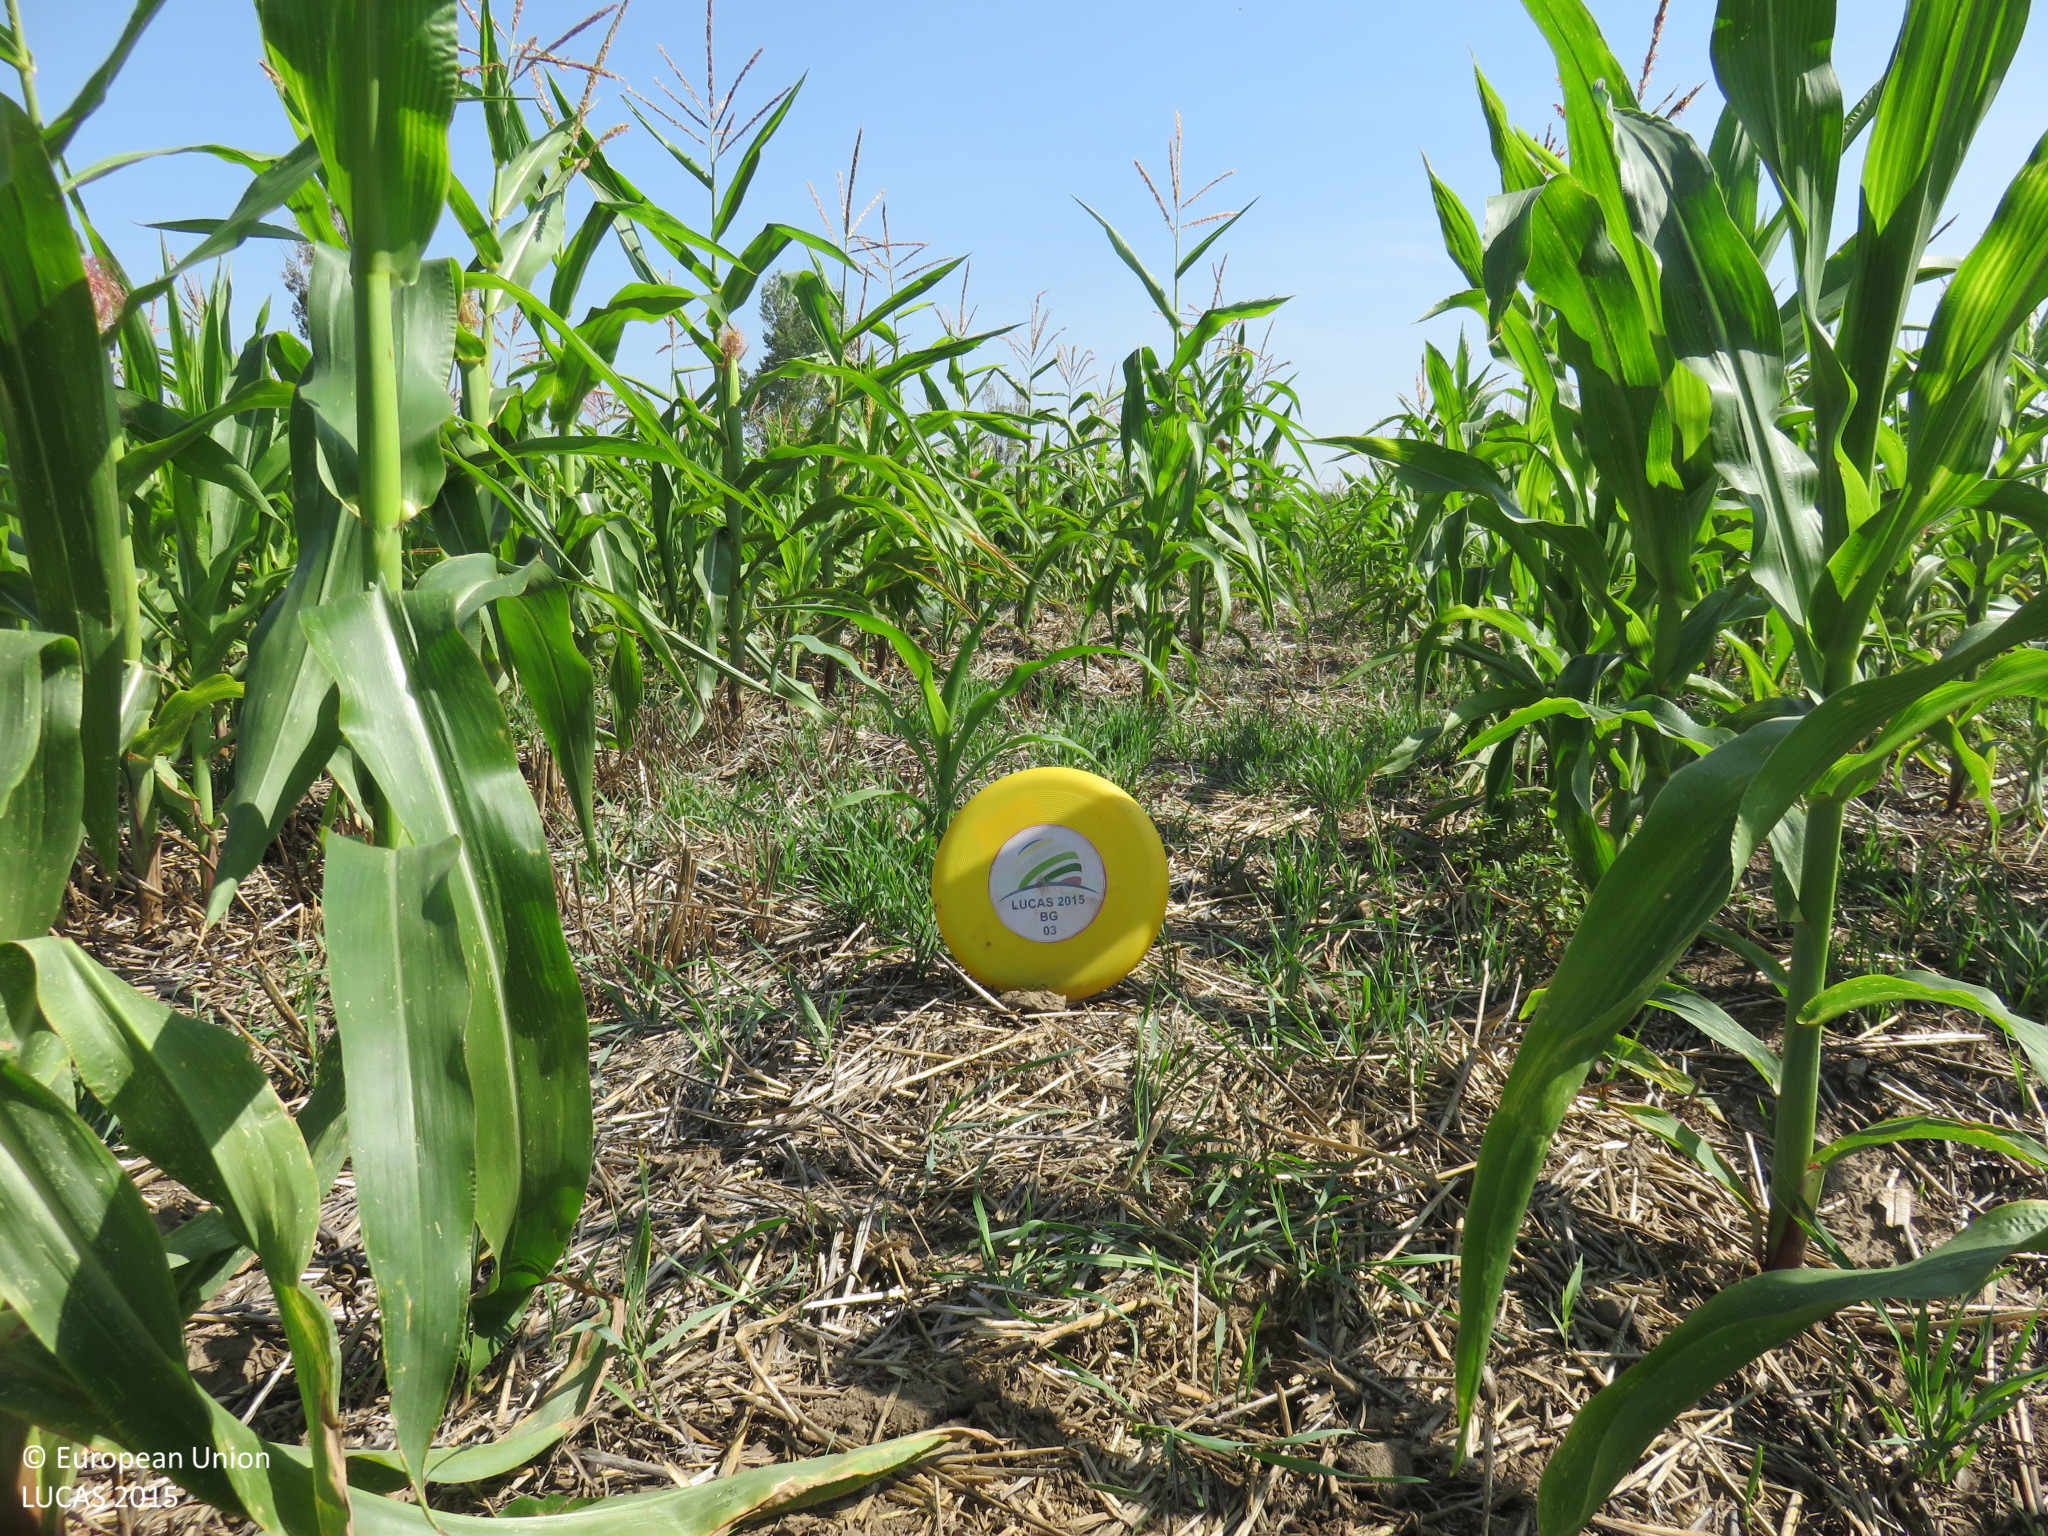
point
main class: Cropland
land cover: Maize
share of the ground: 50 - 75 %
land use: Agriculture (excluding fallow land and kitchen gardens)
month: September
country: BG
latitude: 43.6578
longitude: 24.6102
